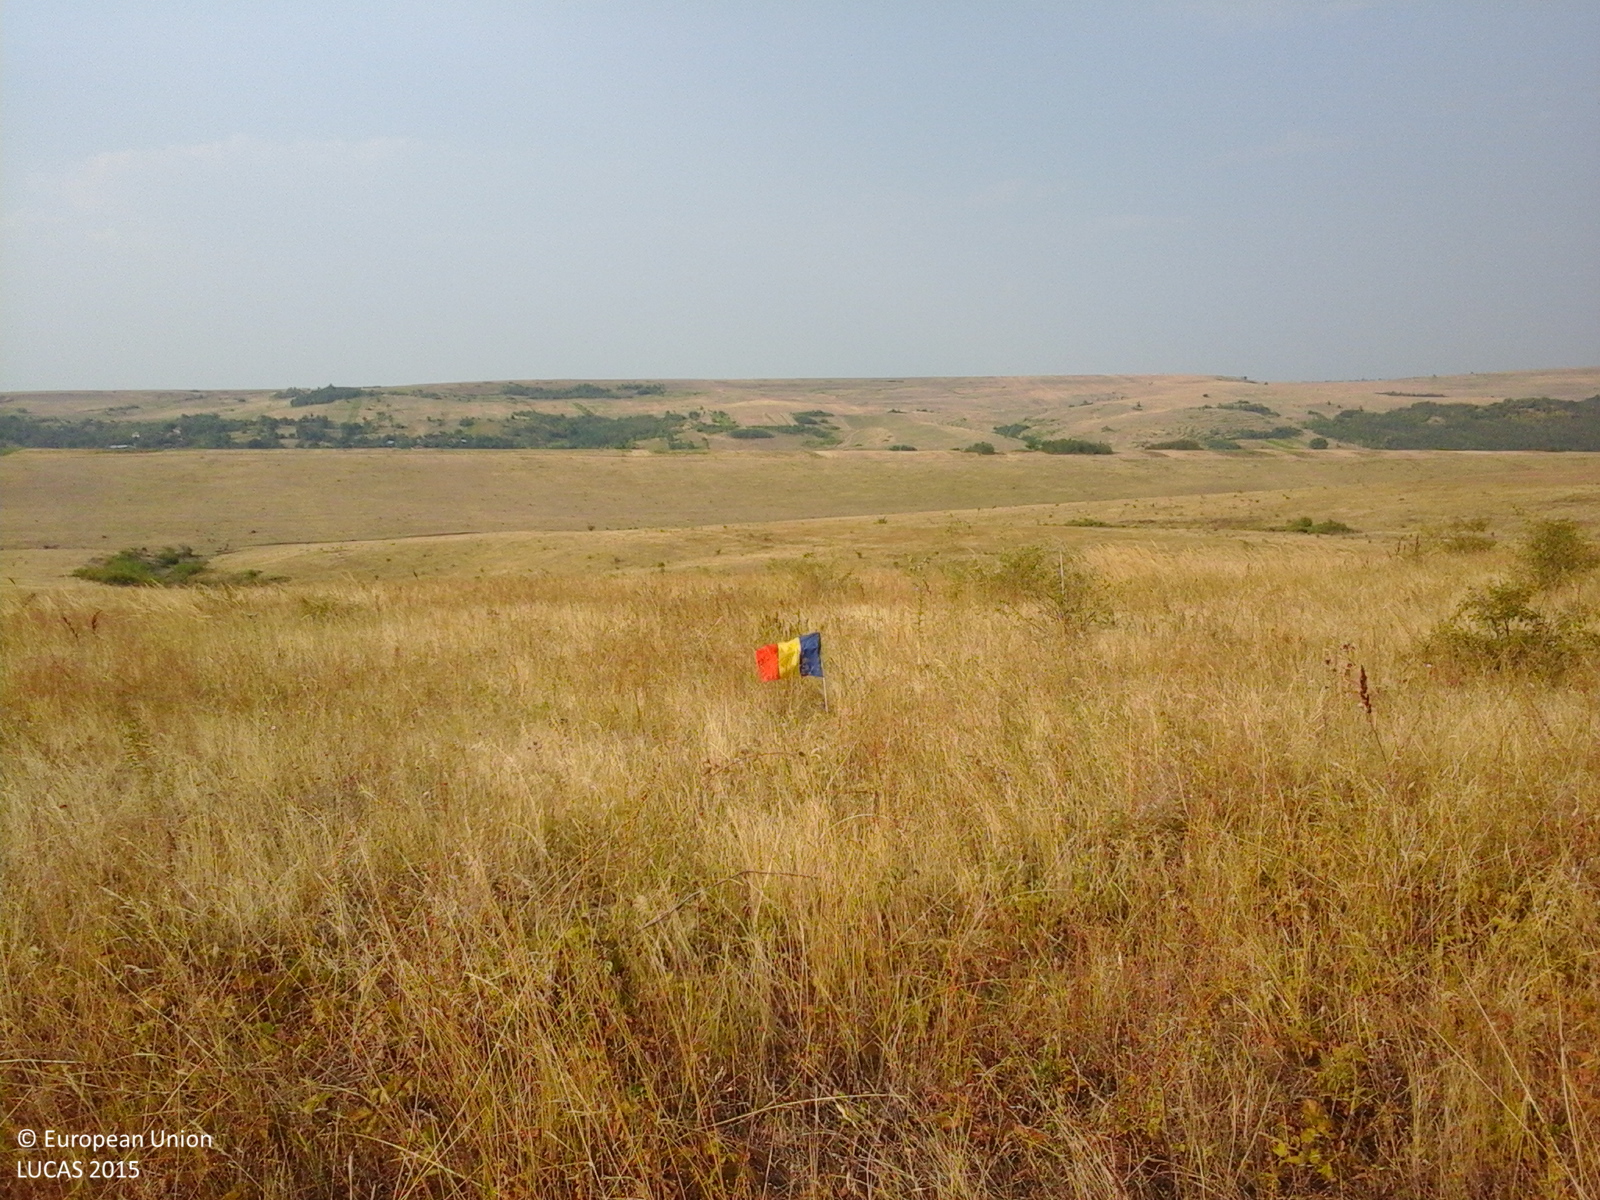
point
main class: Grassland
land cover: Grassland without tree/shrub cover
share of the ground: > 75 %
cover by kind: herbaceous plants 100 %
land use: Agriculture (excluding fallow land and kitchen gardens)
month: August
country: RO
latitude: 44.4769
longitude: 23.0071
